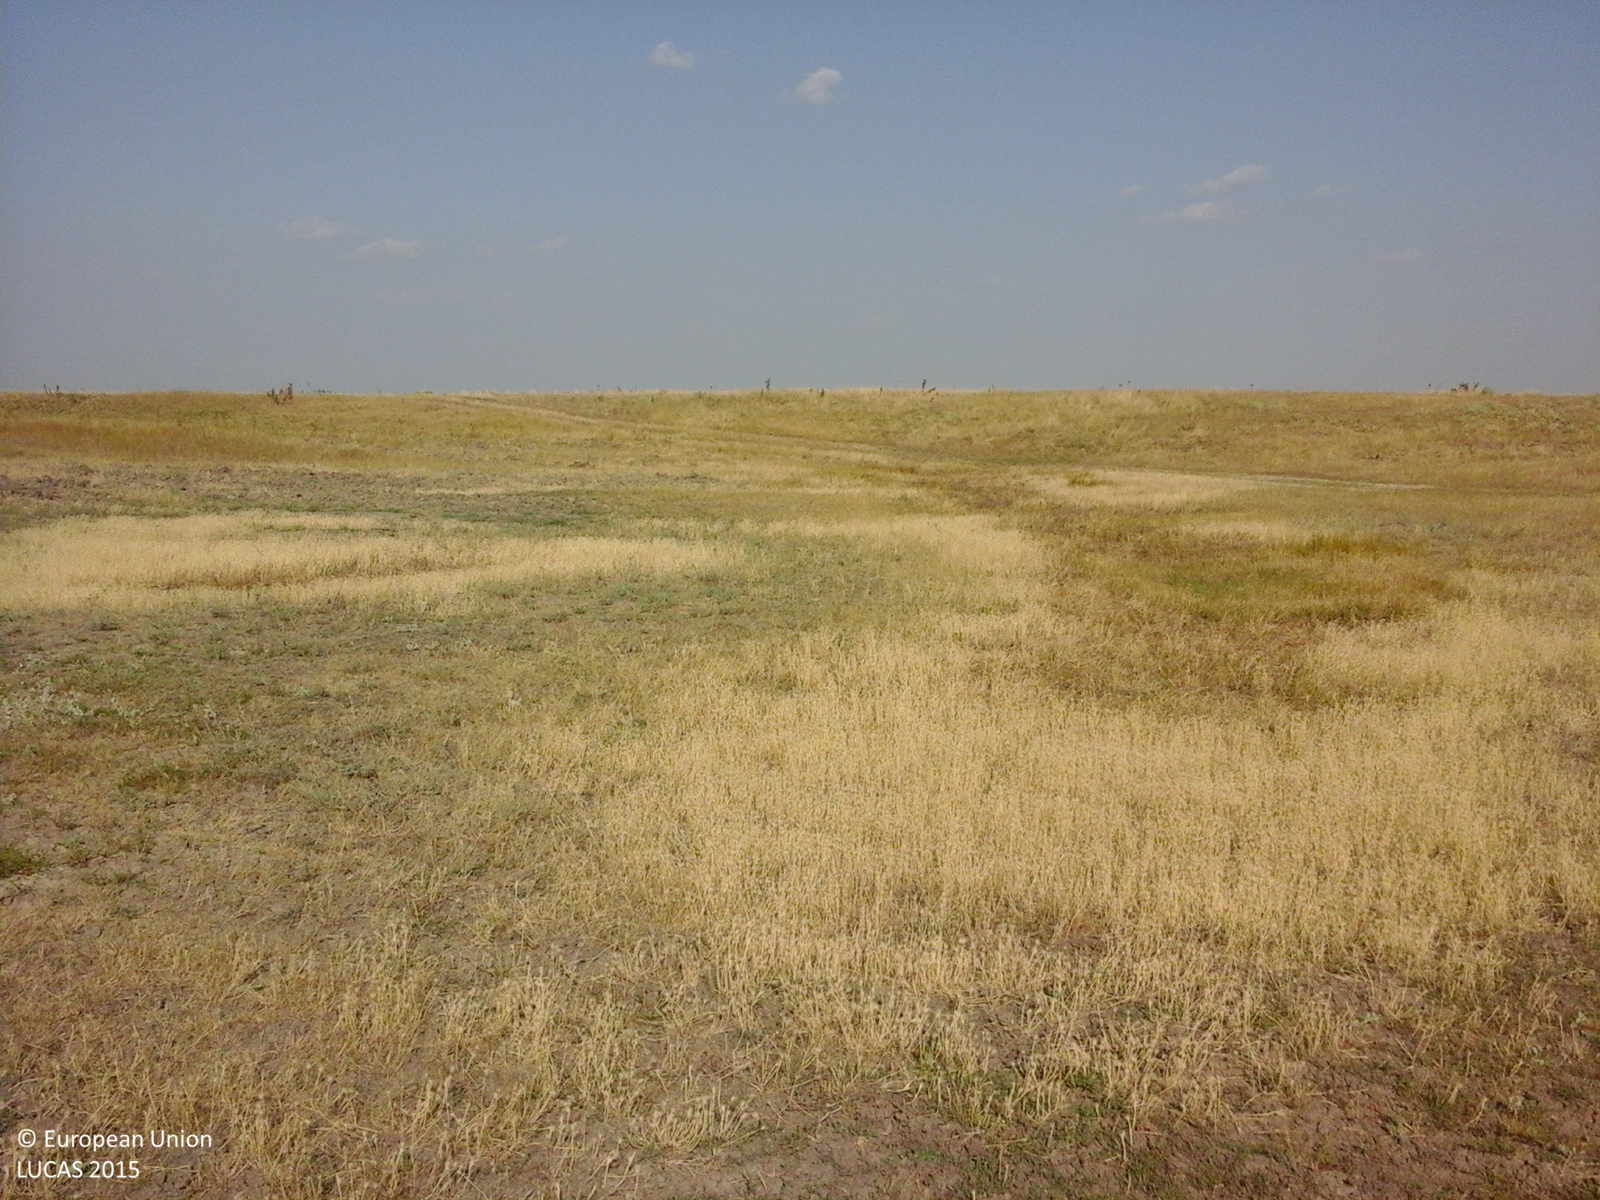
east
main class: Grassland
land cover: Grassland without tree/shrub cover
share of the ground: > 75 %
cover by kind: herbaceous plants 70 %, unconsolidated bare surface 30 %
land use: Agriculture (excluding fallow land and kitchen gardens)
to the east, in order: Grassland without tree/shrub cover; Ditches and canals; Grassland without tree/shrub cover
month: July
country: RO
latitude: 44.9793
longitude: 27.4307
